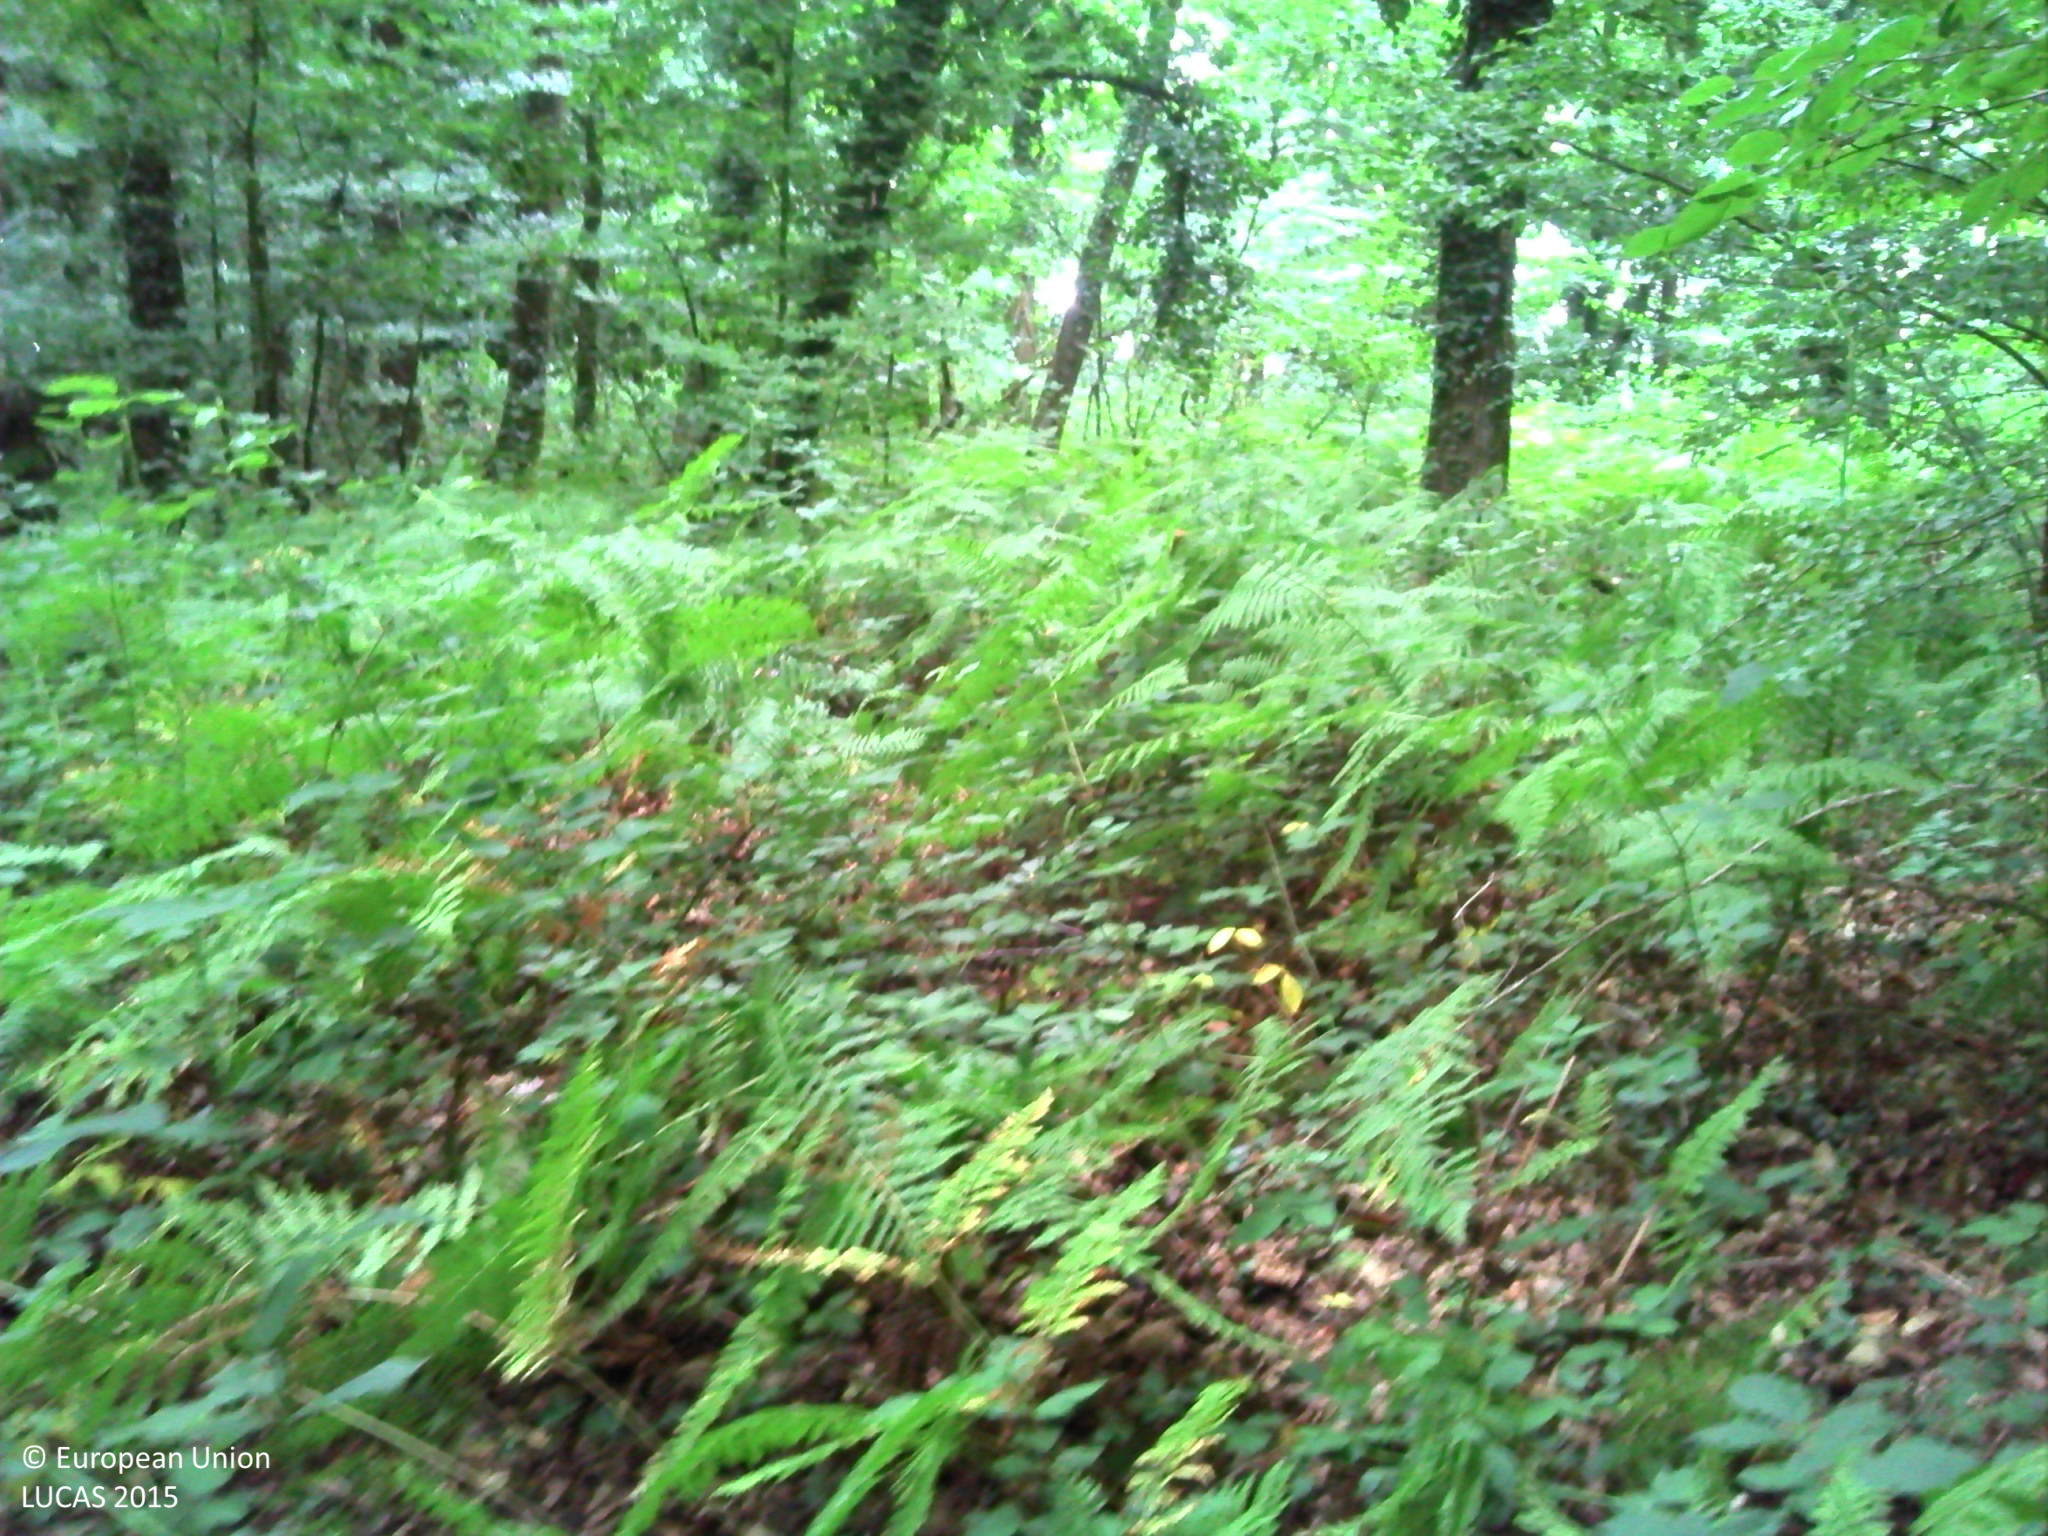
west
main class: Woodland
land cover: Broadleaved woodland
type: mesophytic deciduous forest
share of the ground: > 75 %
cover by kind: broadleaved forest trees 80 %, herbaceous plants 15 %, lichens and mosses 5 %
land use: Forestry
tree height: > 5 m
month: July
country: FR
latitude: 47.8520
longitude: -2.0399
